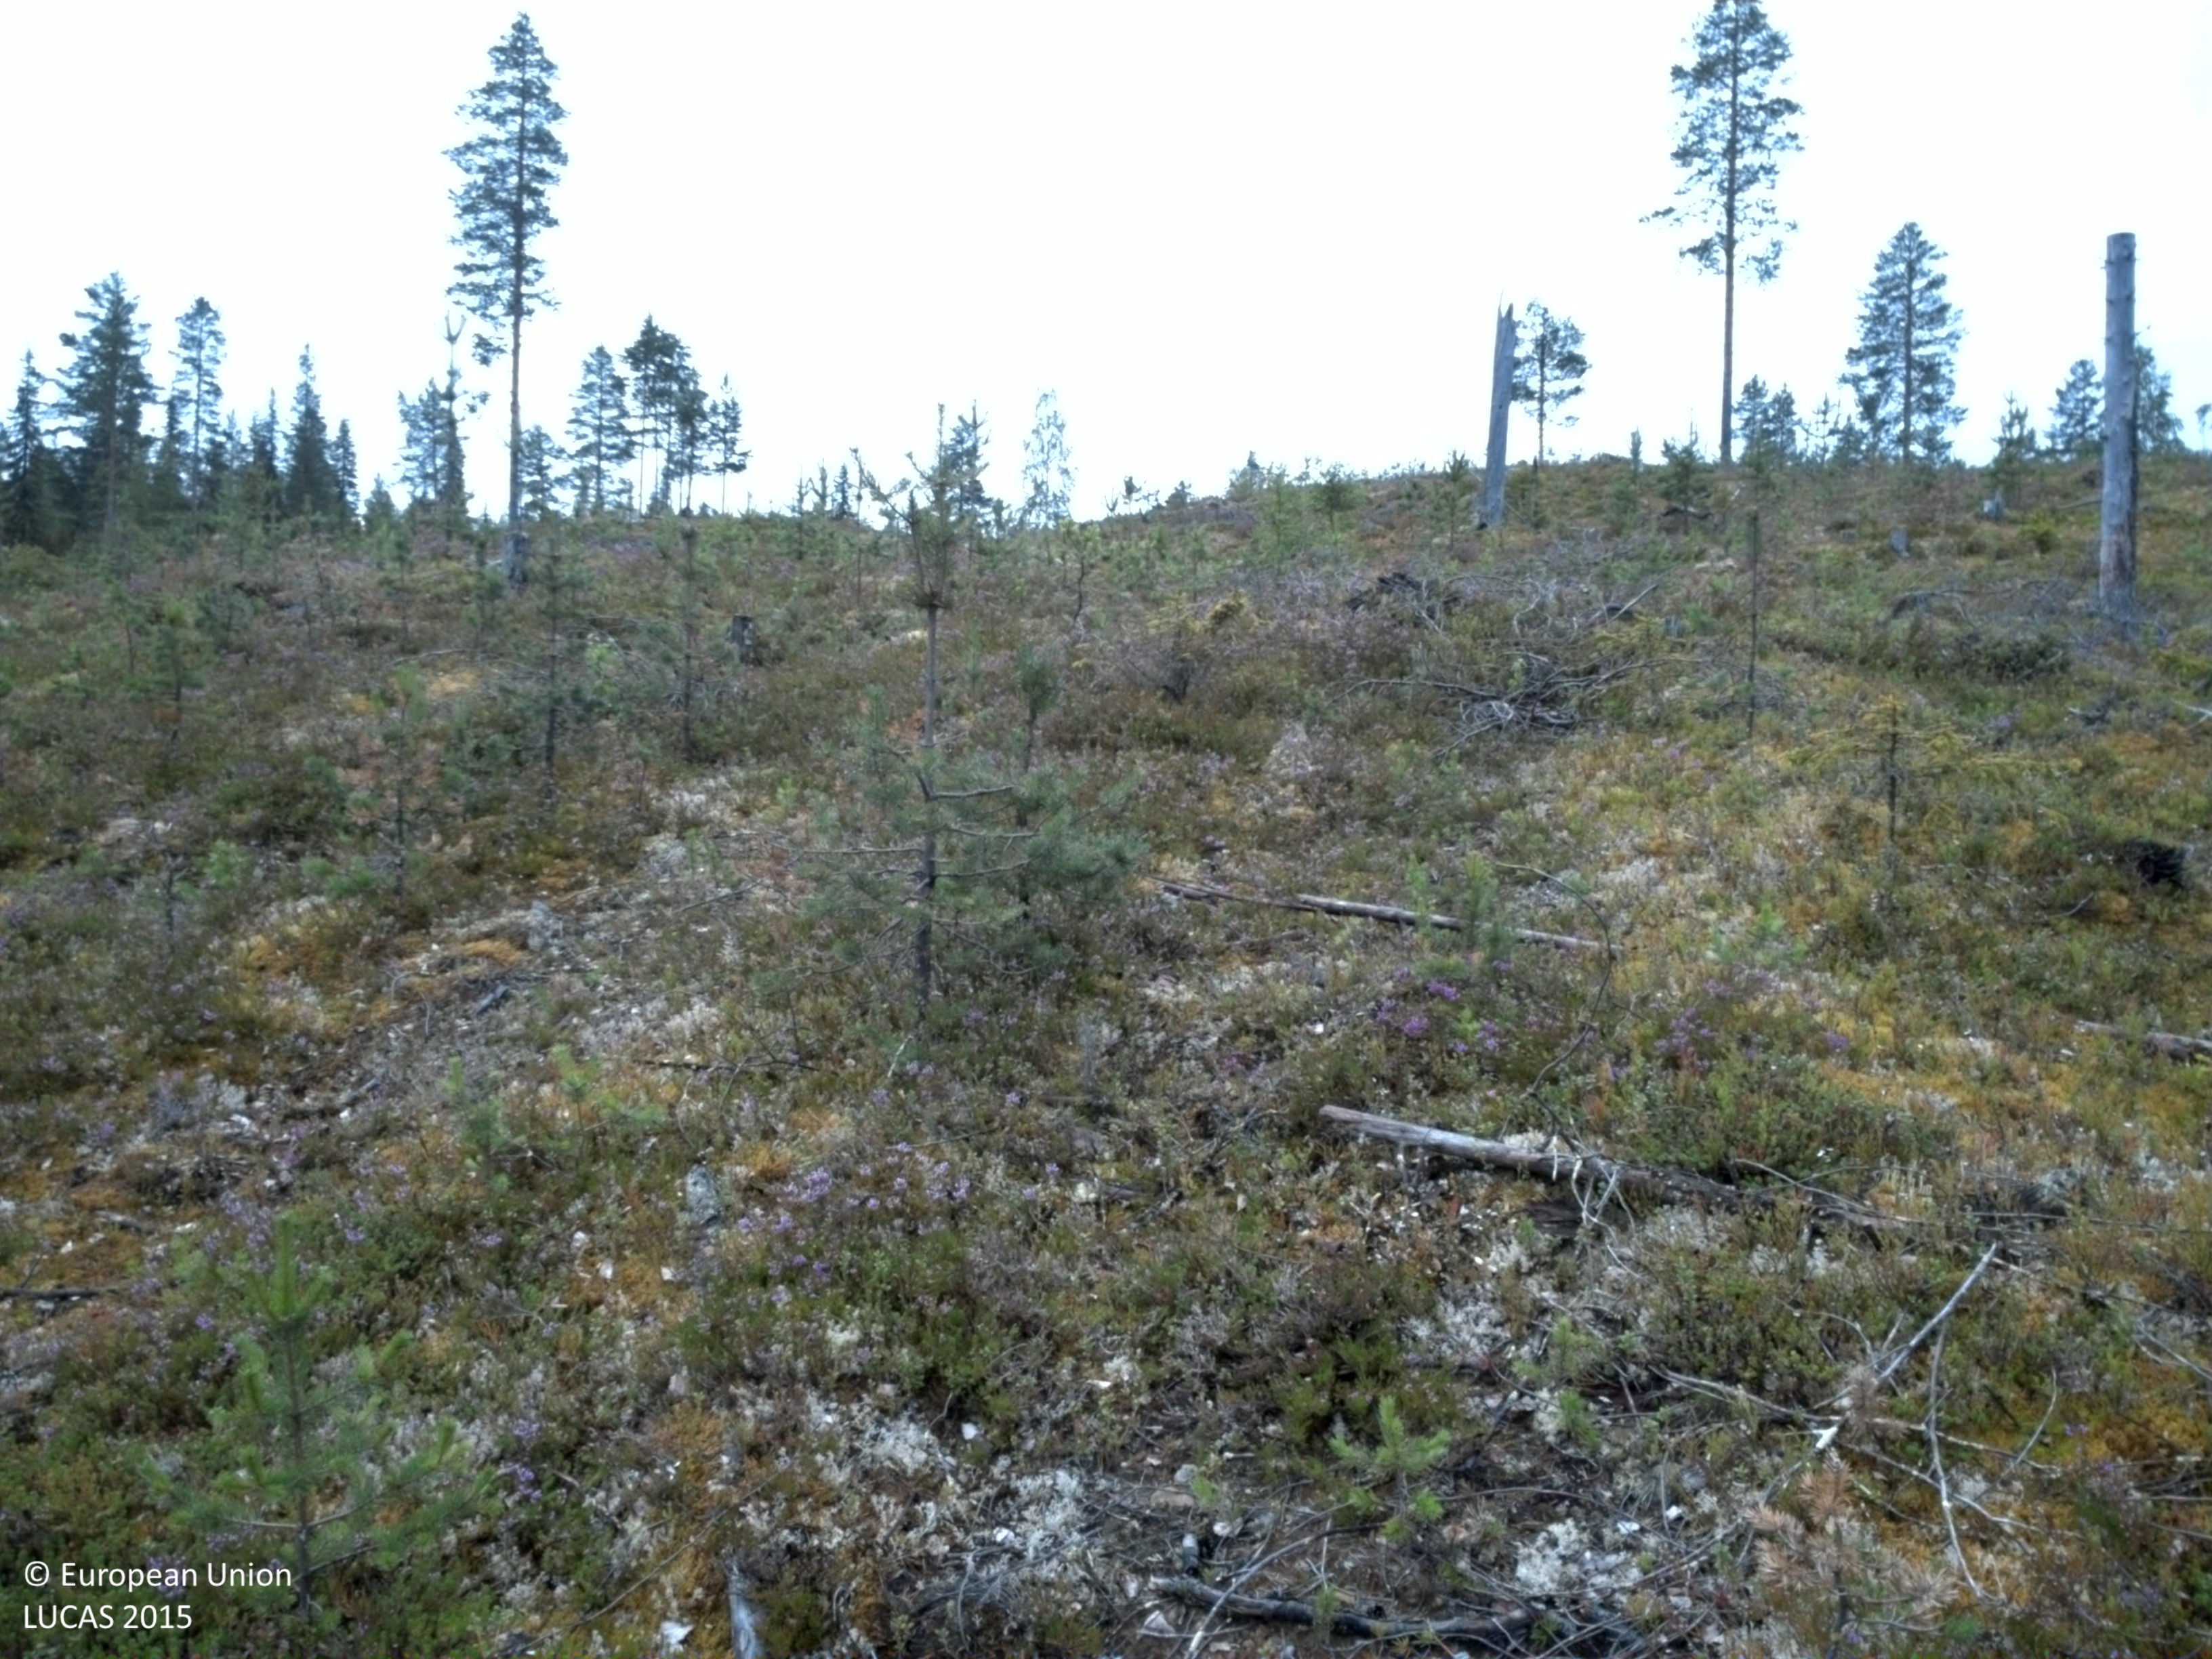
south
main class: Woodland
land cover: Pine dominated coniferous woodland
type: boreal forest
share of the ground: 10 - 25 %
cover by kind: shrubs 80 %, coniferous forest trees 10 %, lichens and mosses 10 %
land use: Forestry
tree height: < 5 m
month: August
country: SE
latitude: 66.4591
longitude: 20.5247
